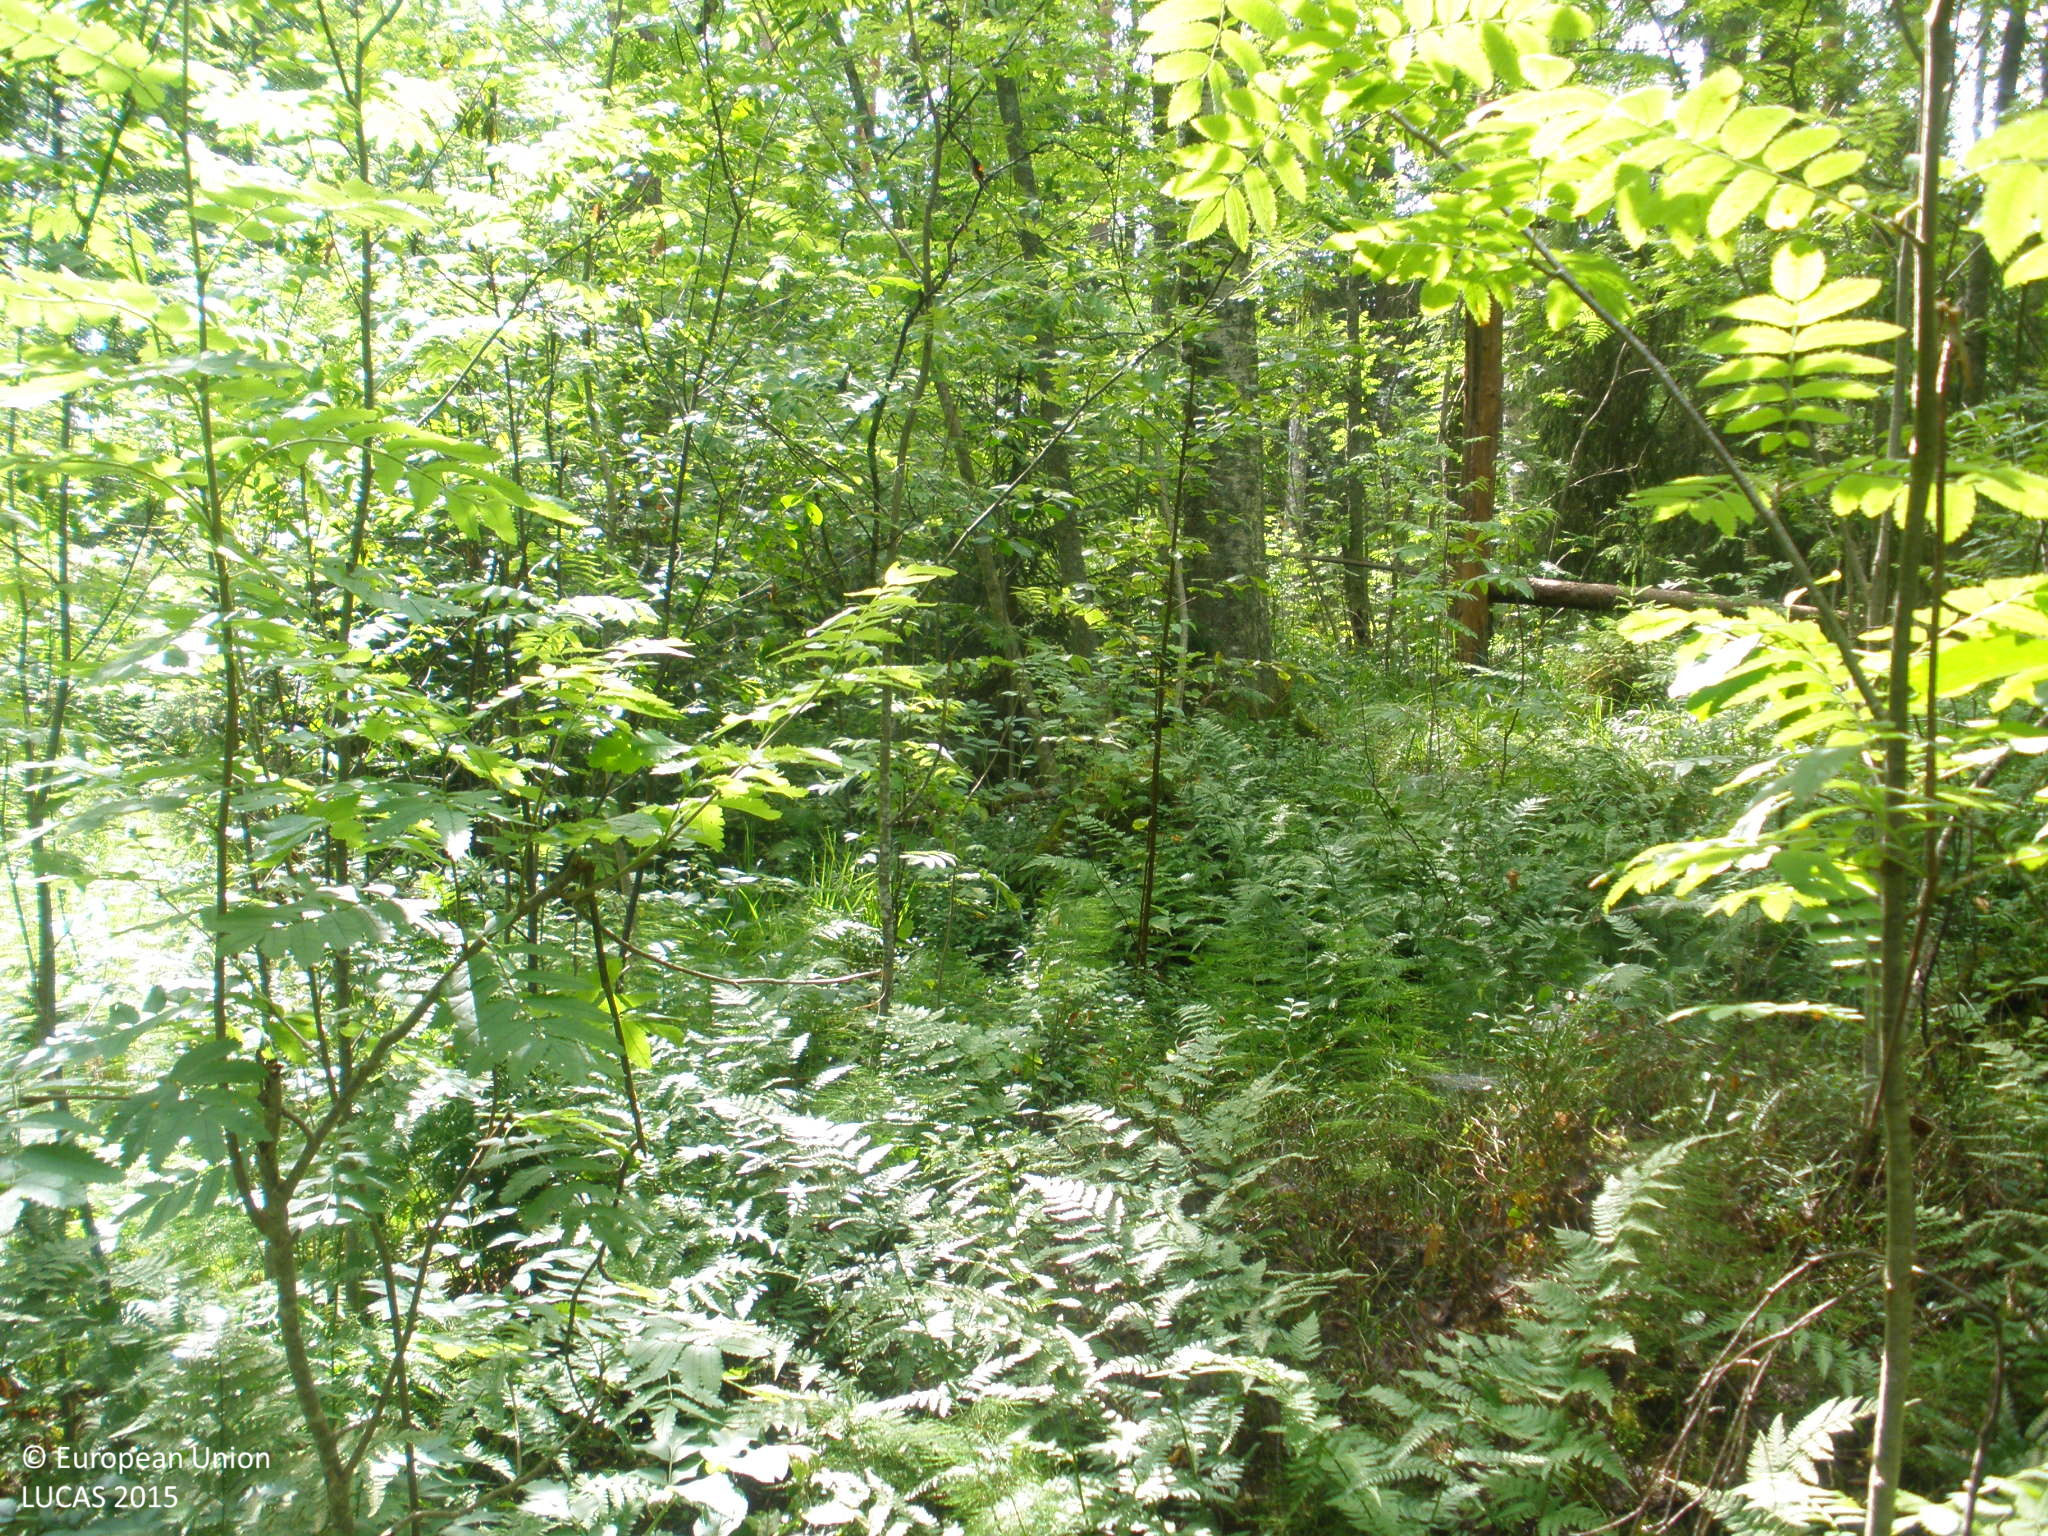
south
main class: Woodland
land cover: Broadleaved woodland
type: boreal forest
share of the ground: > 75 %
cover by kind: broadleaved forest trees 80 %, herbaceous plants 10 %, coniferous forest trees 5 %, shrubs 5 %
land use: Forestry
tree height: > 5 m
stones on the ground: 10 - 25 %
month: July
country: FI
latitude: 61.3298
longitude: 24.7351
